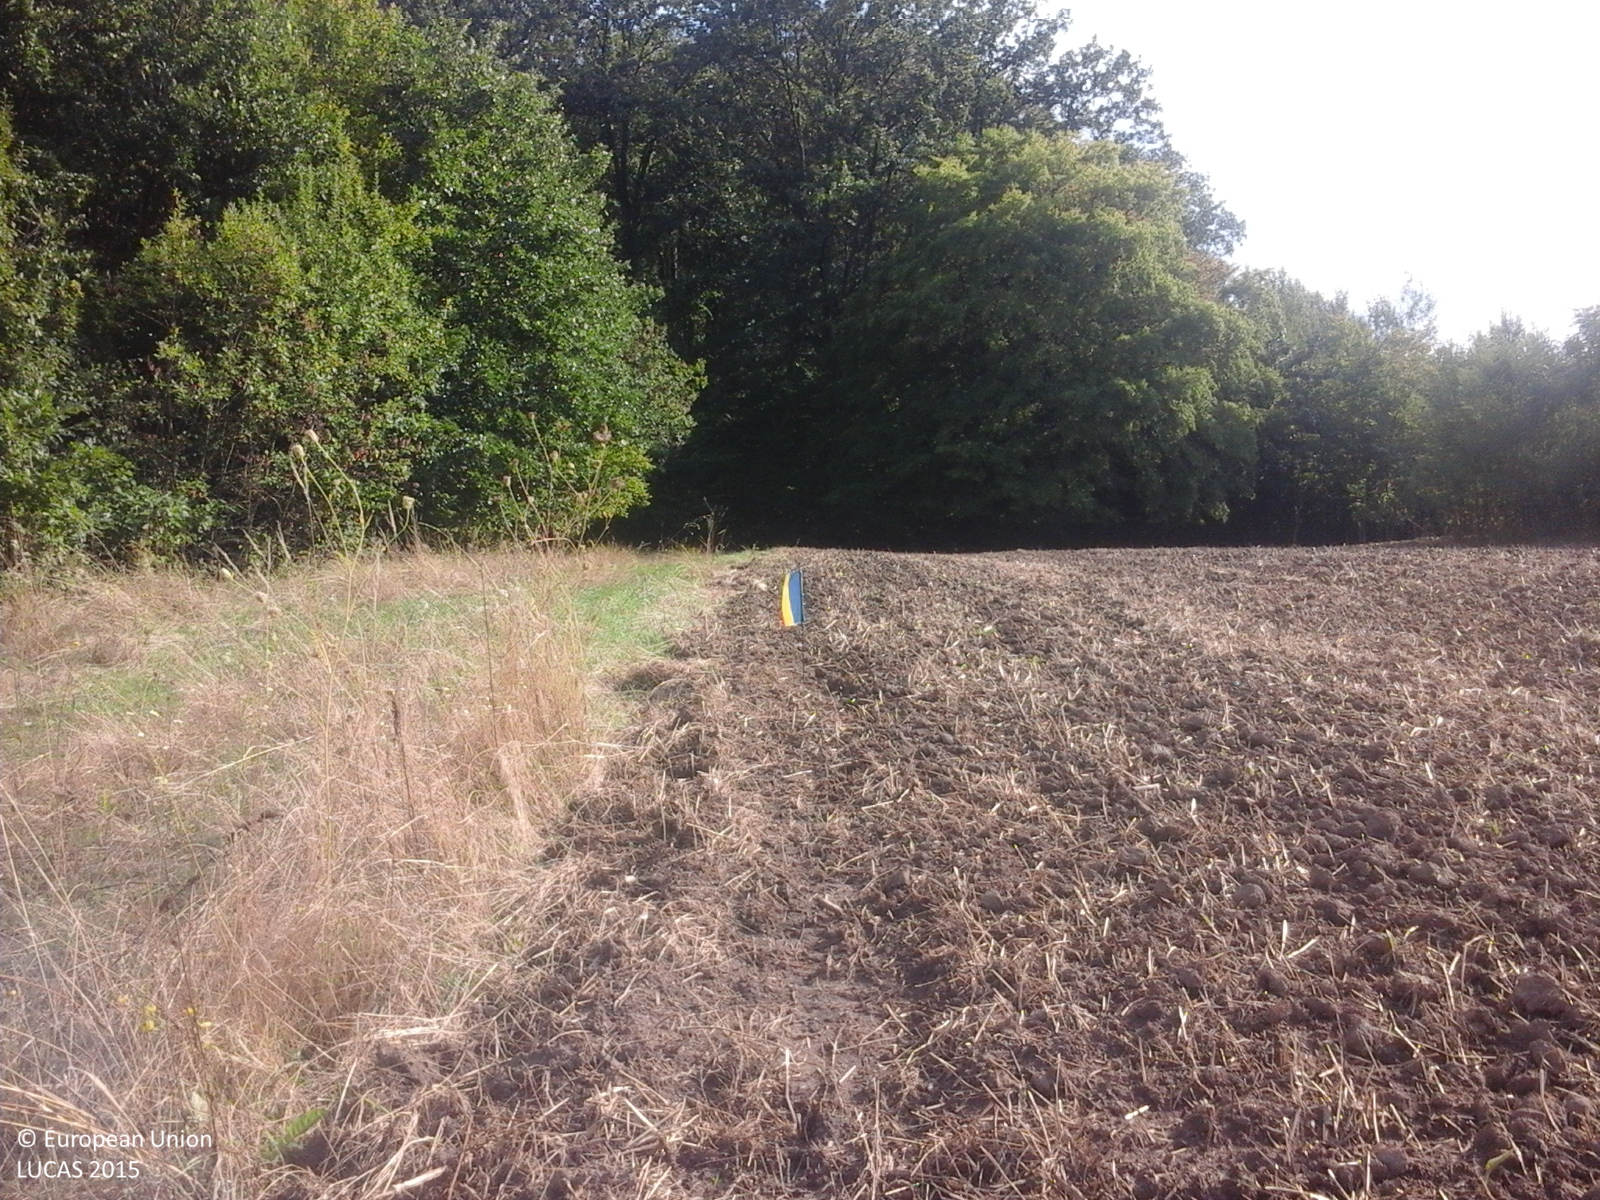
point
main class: Cropland
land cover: Common wheat
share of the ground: 10 - 25 %
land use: Agriculture (excluding fallow land and kitchen gardens)
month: September
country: RO
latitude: 47.4055
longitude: 23.0654
